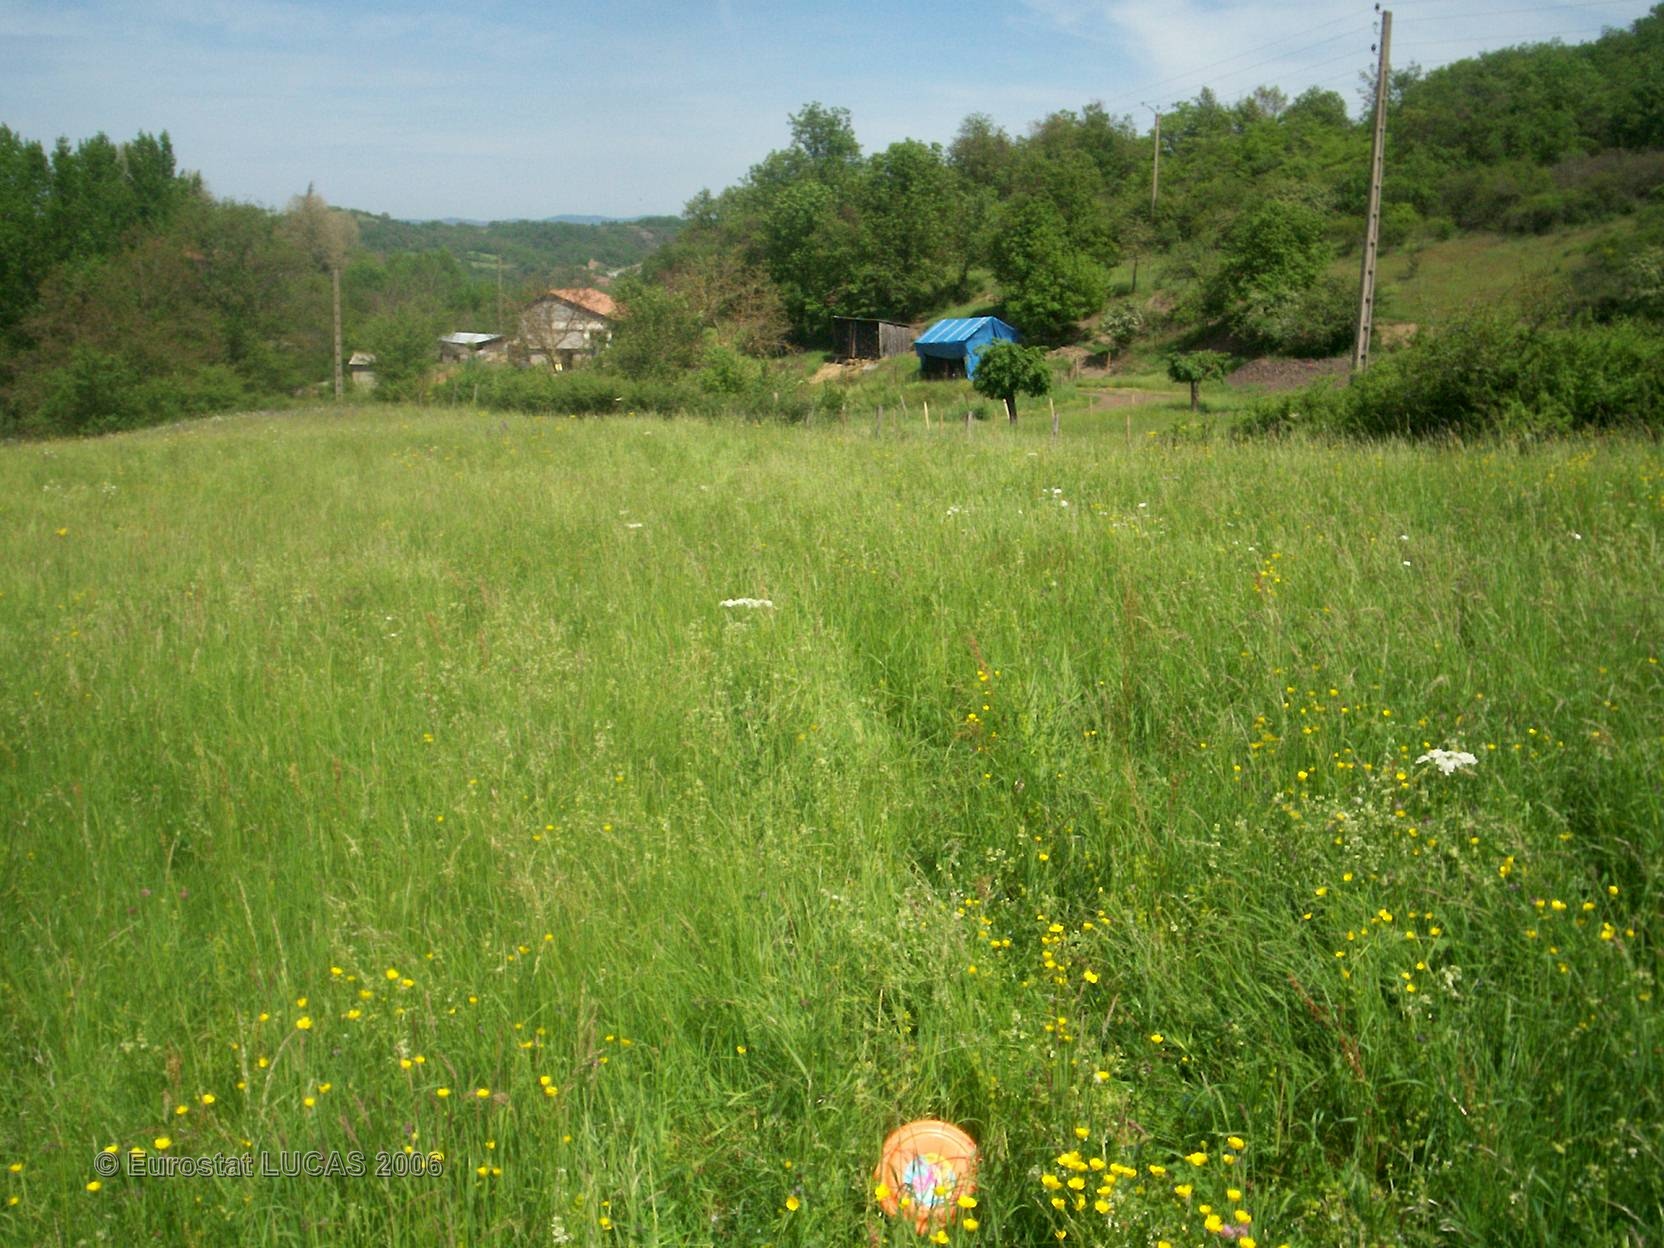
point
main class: Grassland
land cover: Grassland without tree/shrub cover
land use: Agriculture (excluding fallow land and kitchen gardens)
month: May
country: FR
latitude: 45.4371
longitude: 3.3158
